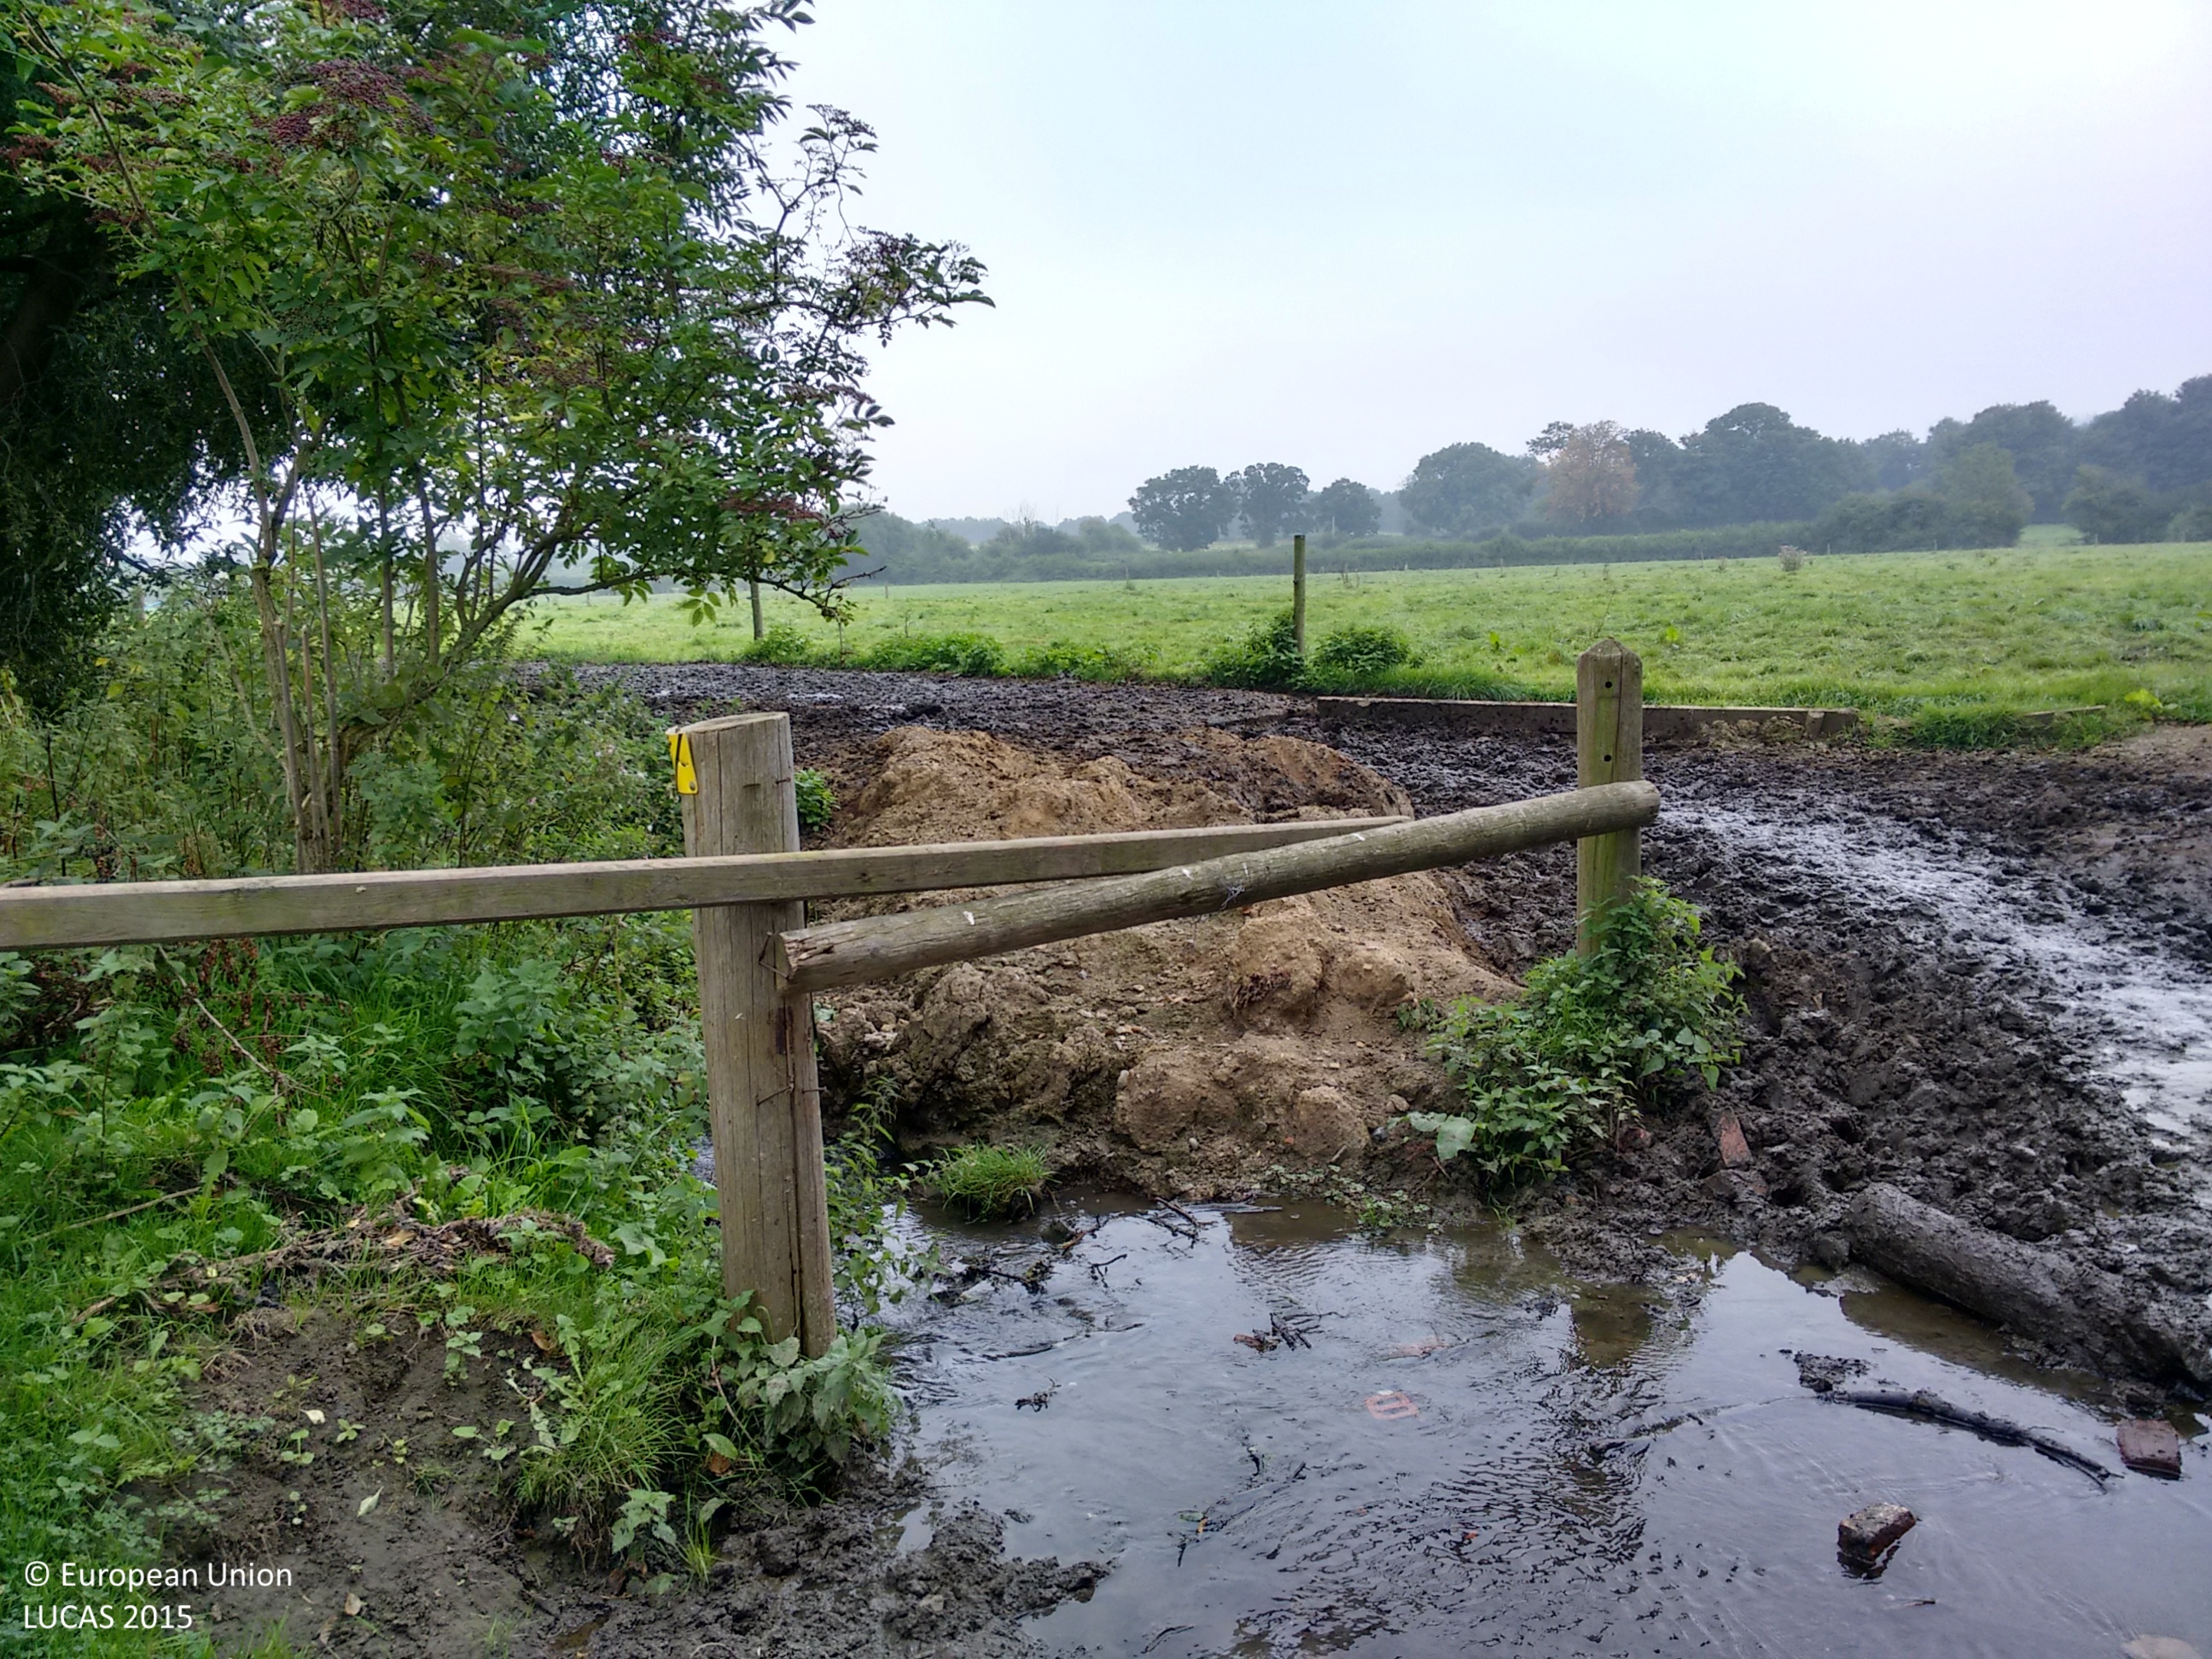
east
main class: Grassland
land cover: Grassland without tree/shrub cover
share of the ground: > 75 %
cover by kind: herbaceous plants 100 %
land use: Agriculture (excluding fallow land and kitchen gardens)
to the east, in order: Grassland without tree/shrub cover; Fences; Tracks; Grassland without tree/shrub cover; Managed hedges; Grassland without tree/shrub cover; Managed hedges; Ditches and canals; Grass margins; Tracks; Fences; Grassland without tree/shrub cover
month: September
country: GB
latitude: 52.6547
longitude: -2.8896
